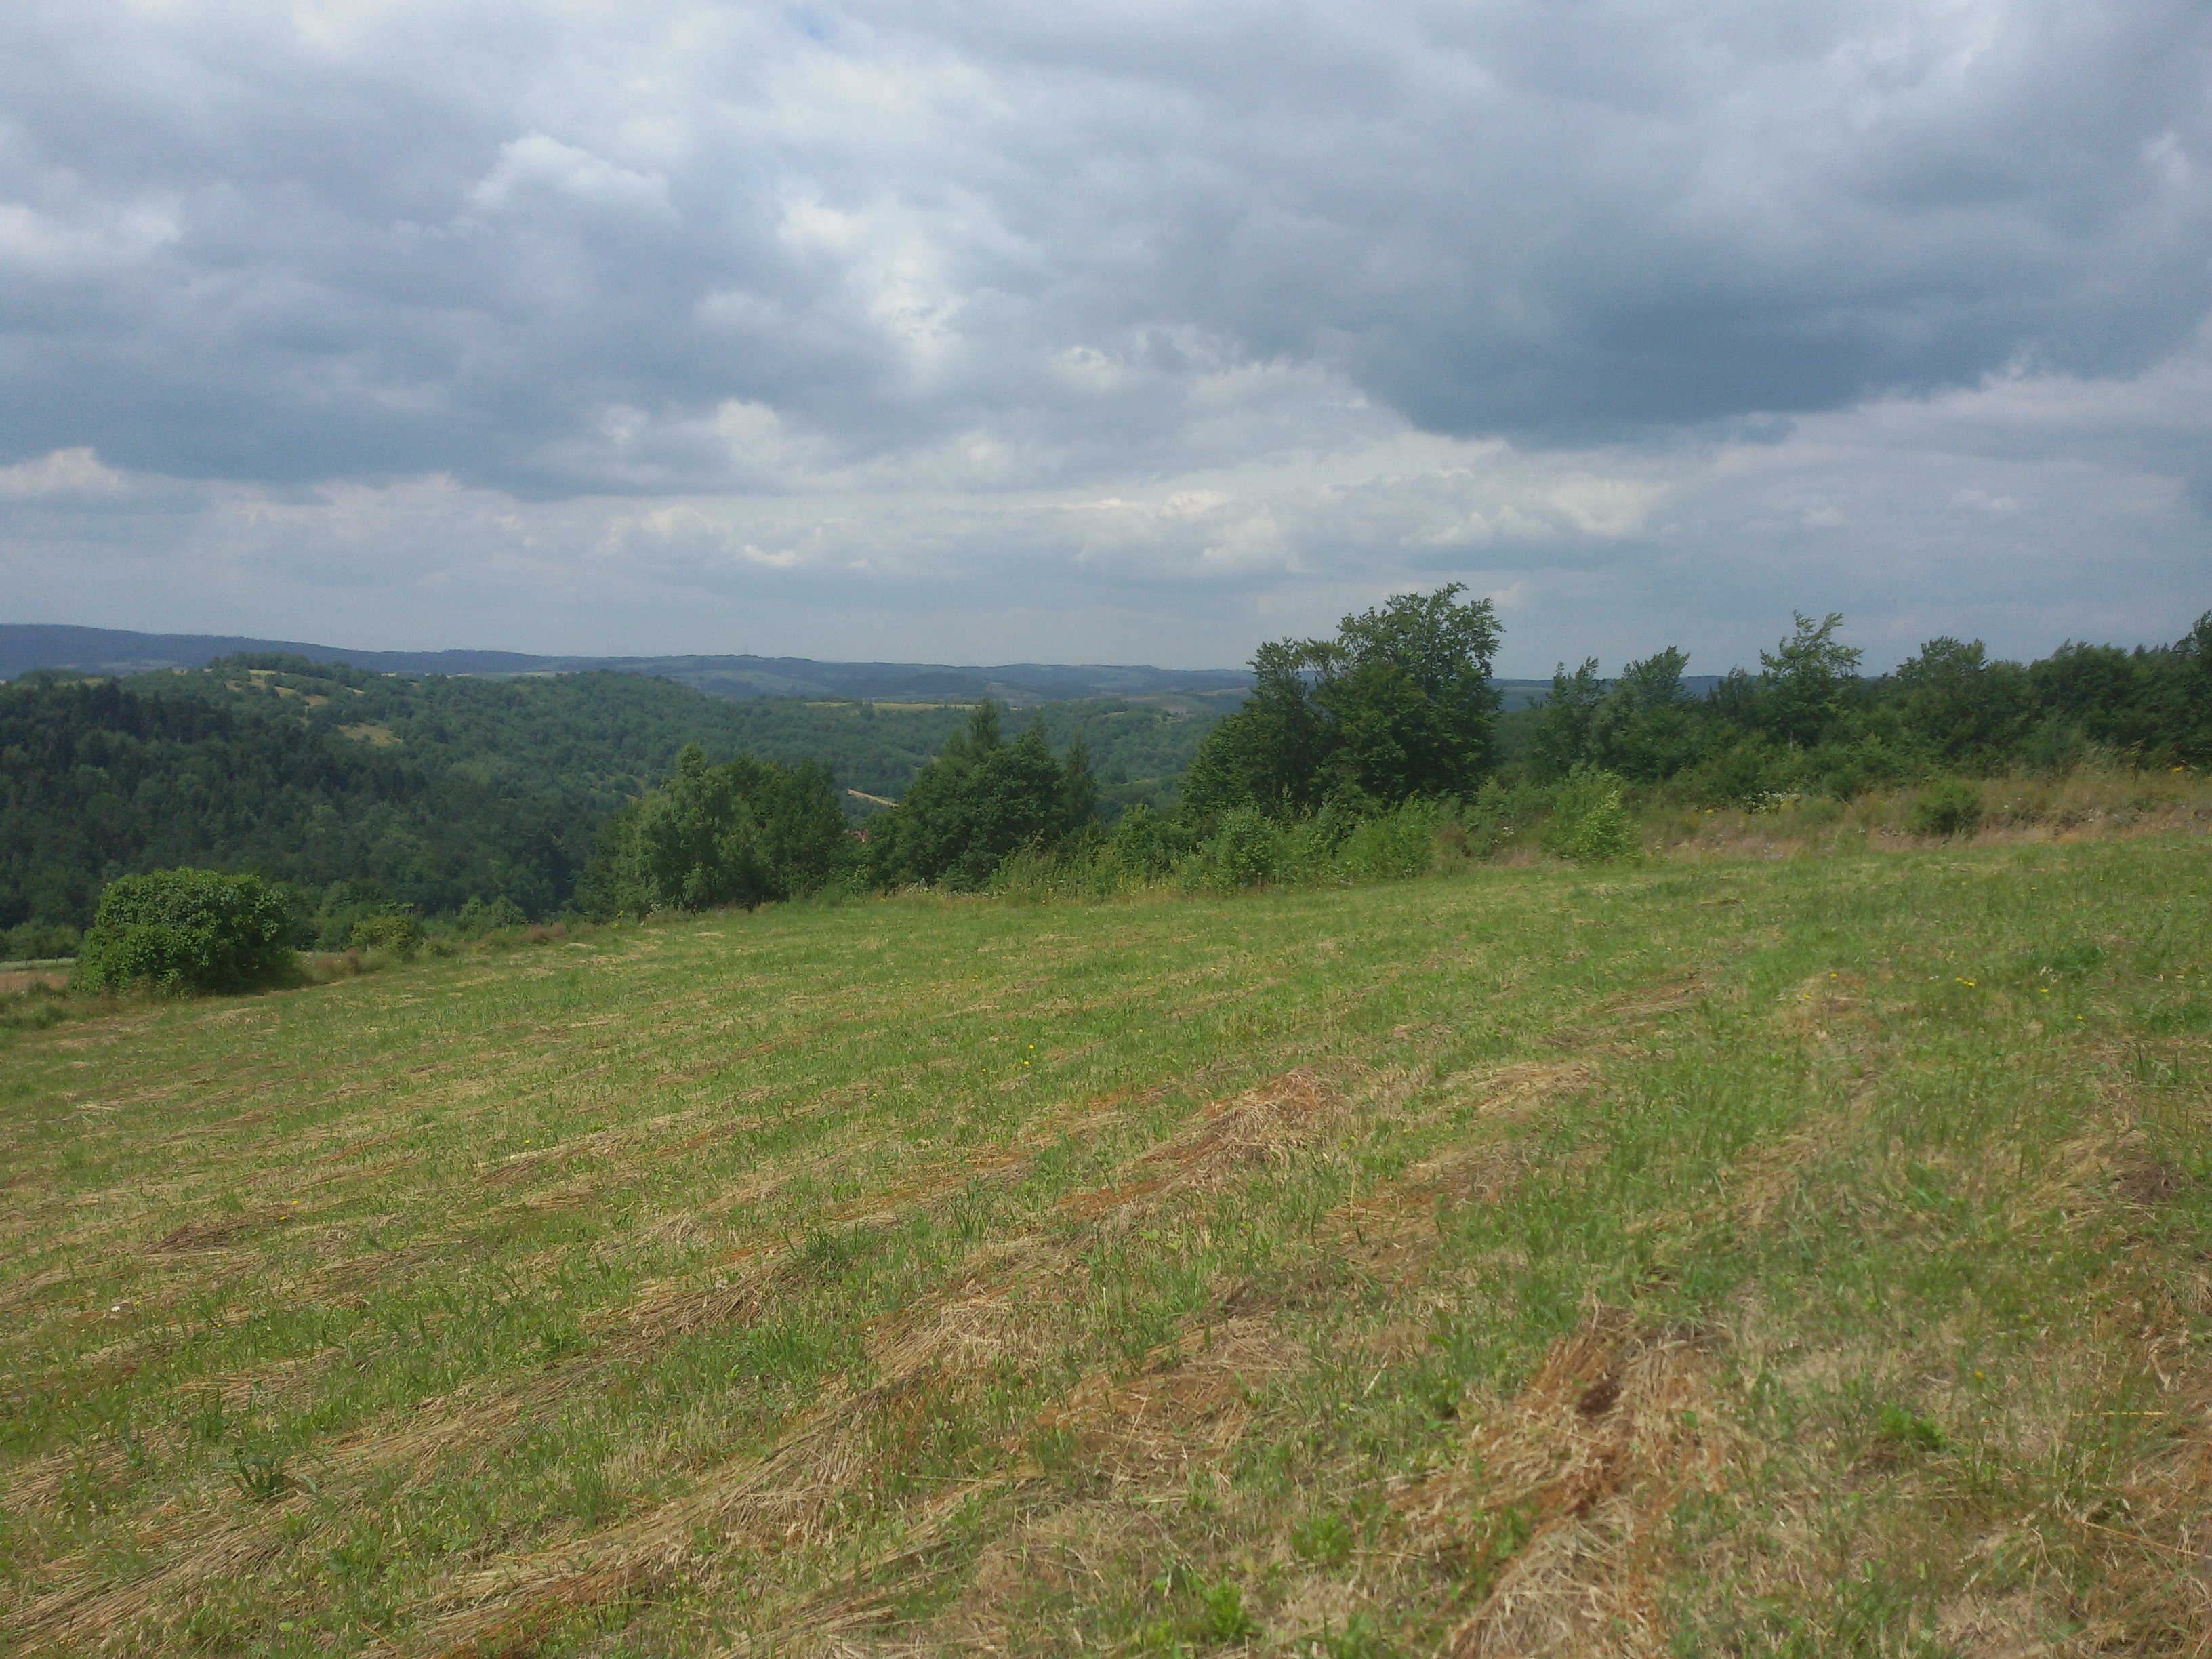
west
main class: Grassland
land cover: Grassland without tree/shrub cover
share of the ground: > 75 %
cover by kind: herbaceous plants 100 %
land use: Agriculture (excluding fallow land and kitchen gardens)
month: July
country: PL
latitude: 49.7735
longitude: 22.2667
